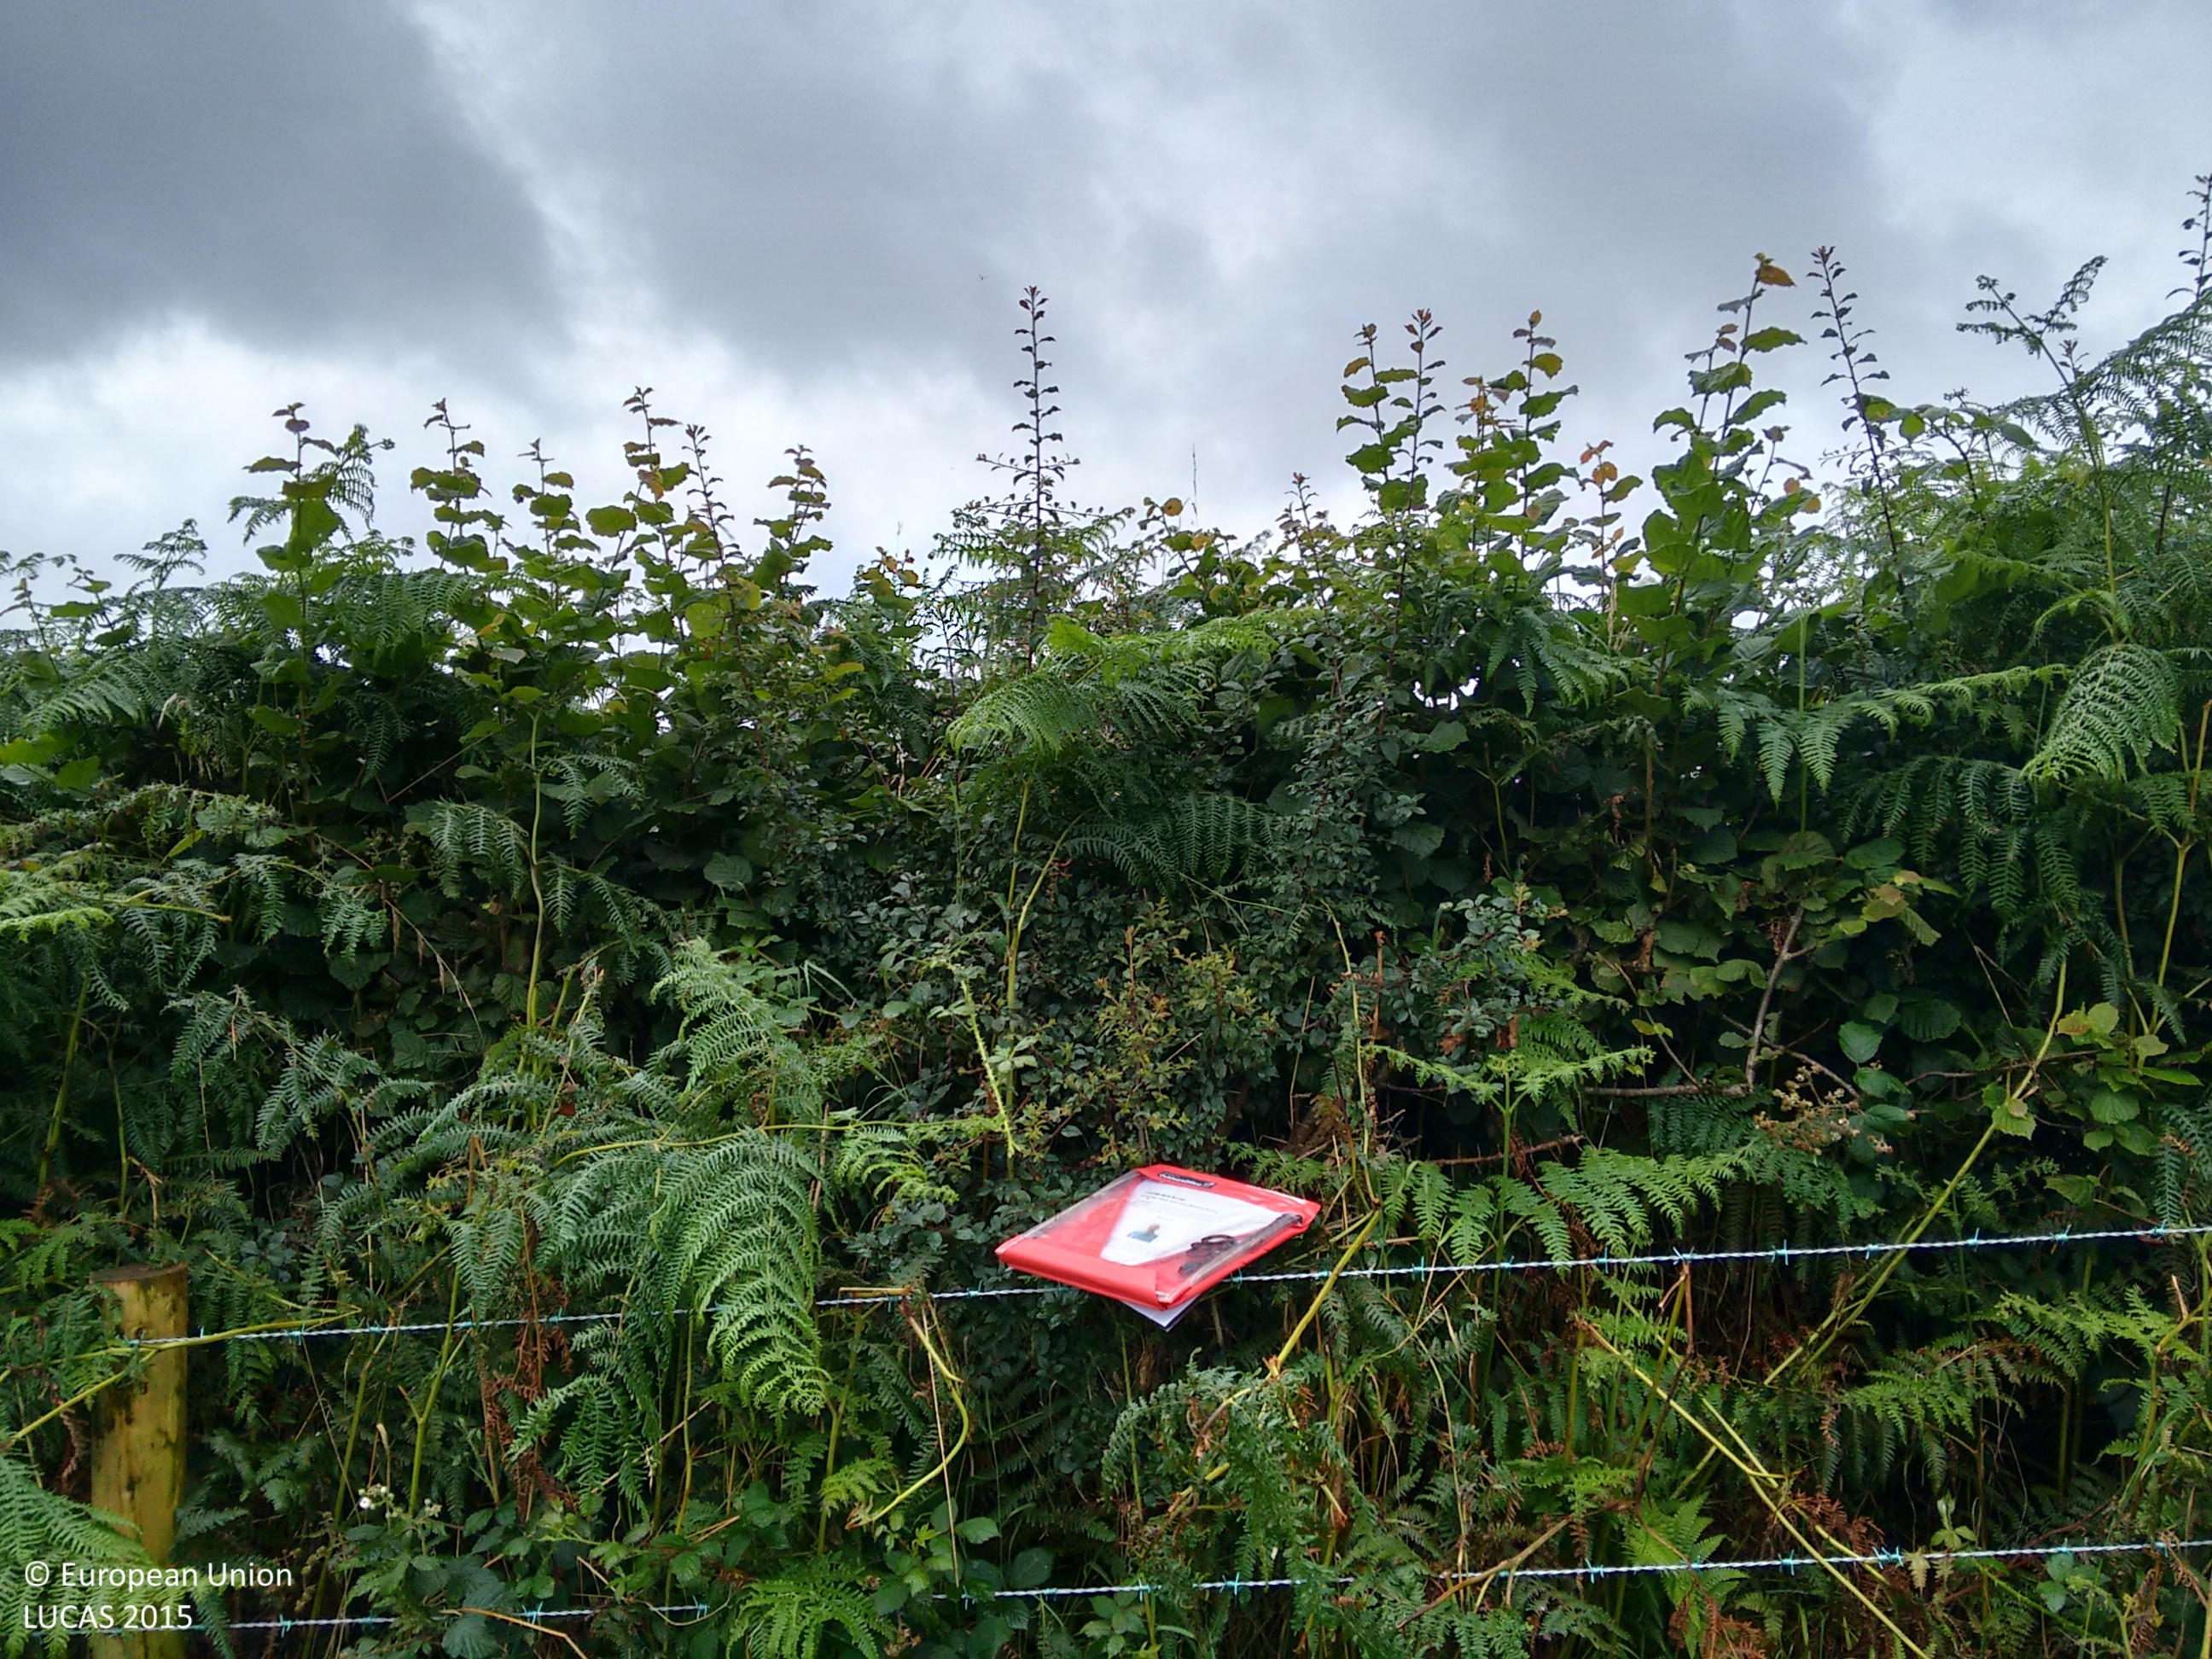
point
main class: Grassland
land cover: Grassland without tree/shrub cover
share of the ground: > 75 %
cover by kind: herbaceous plants 100 %
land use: Agriculture (excluding fallow land and kitchen gardens)
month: August
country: GB
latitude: 51.8569
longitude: -4.8508
